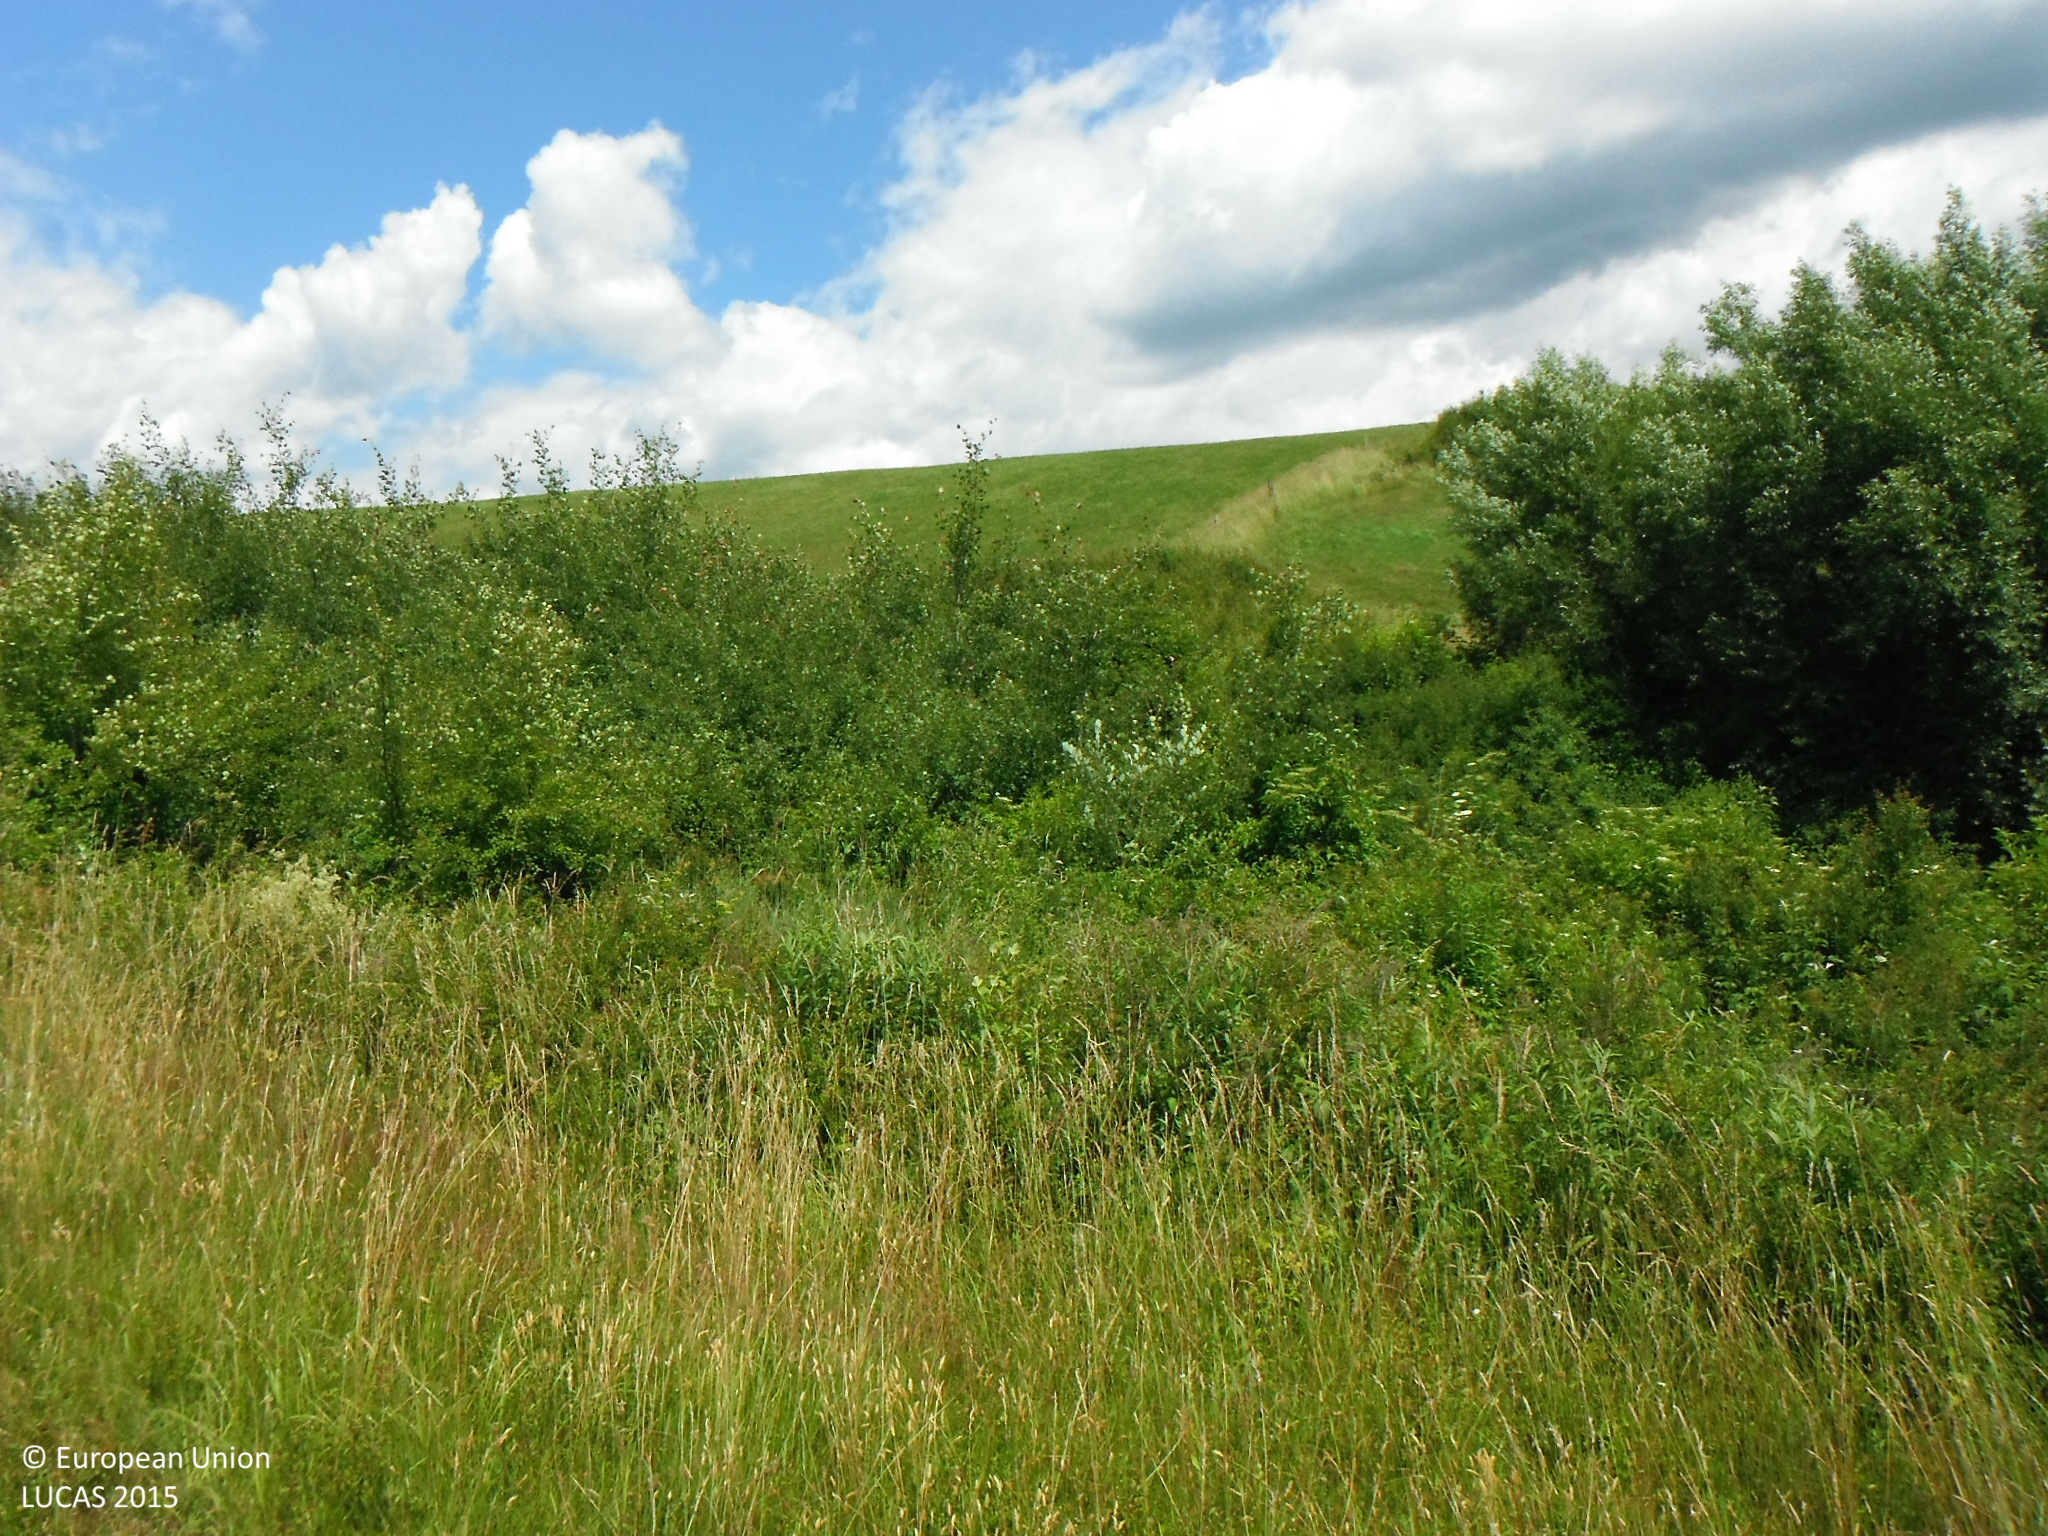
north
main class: Grassland
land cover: Grassland without tree/shrub cover
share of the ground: > 75 %
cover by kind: herbaceous plants 100 %
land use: Agriculture (excluding fallow land and kitchen gardens)
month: June
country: SK
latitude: 48.9078
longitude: 21.1633
